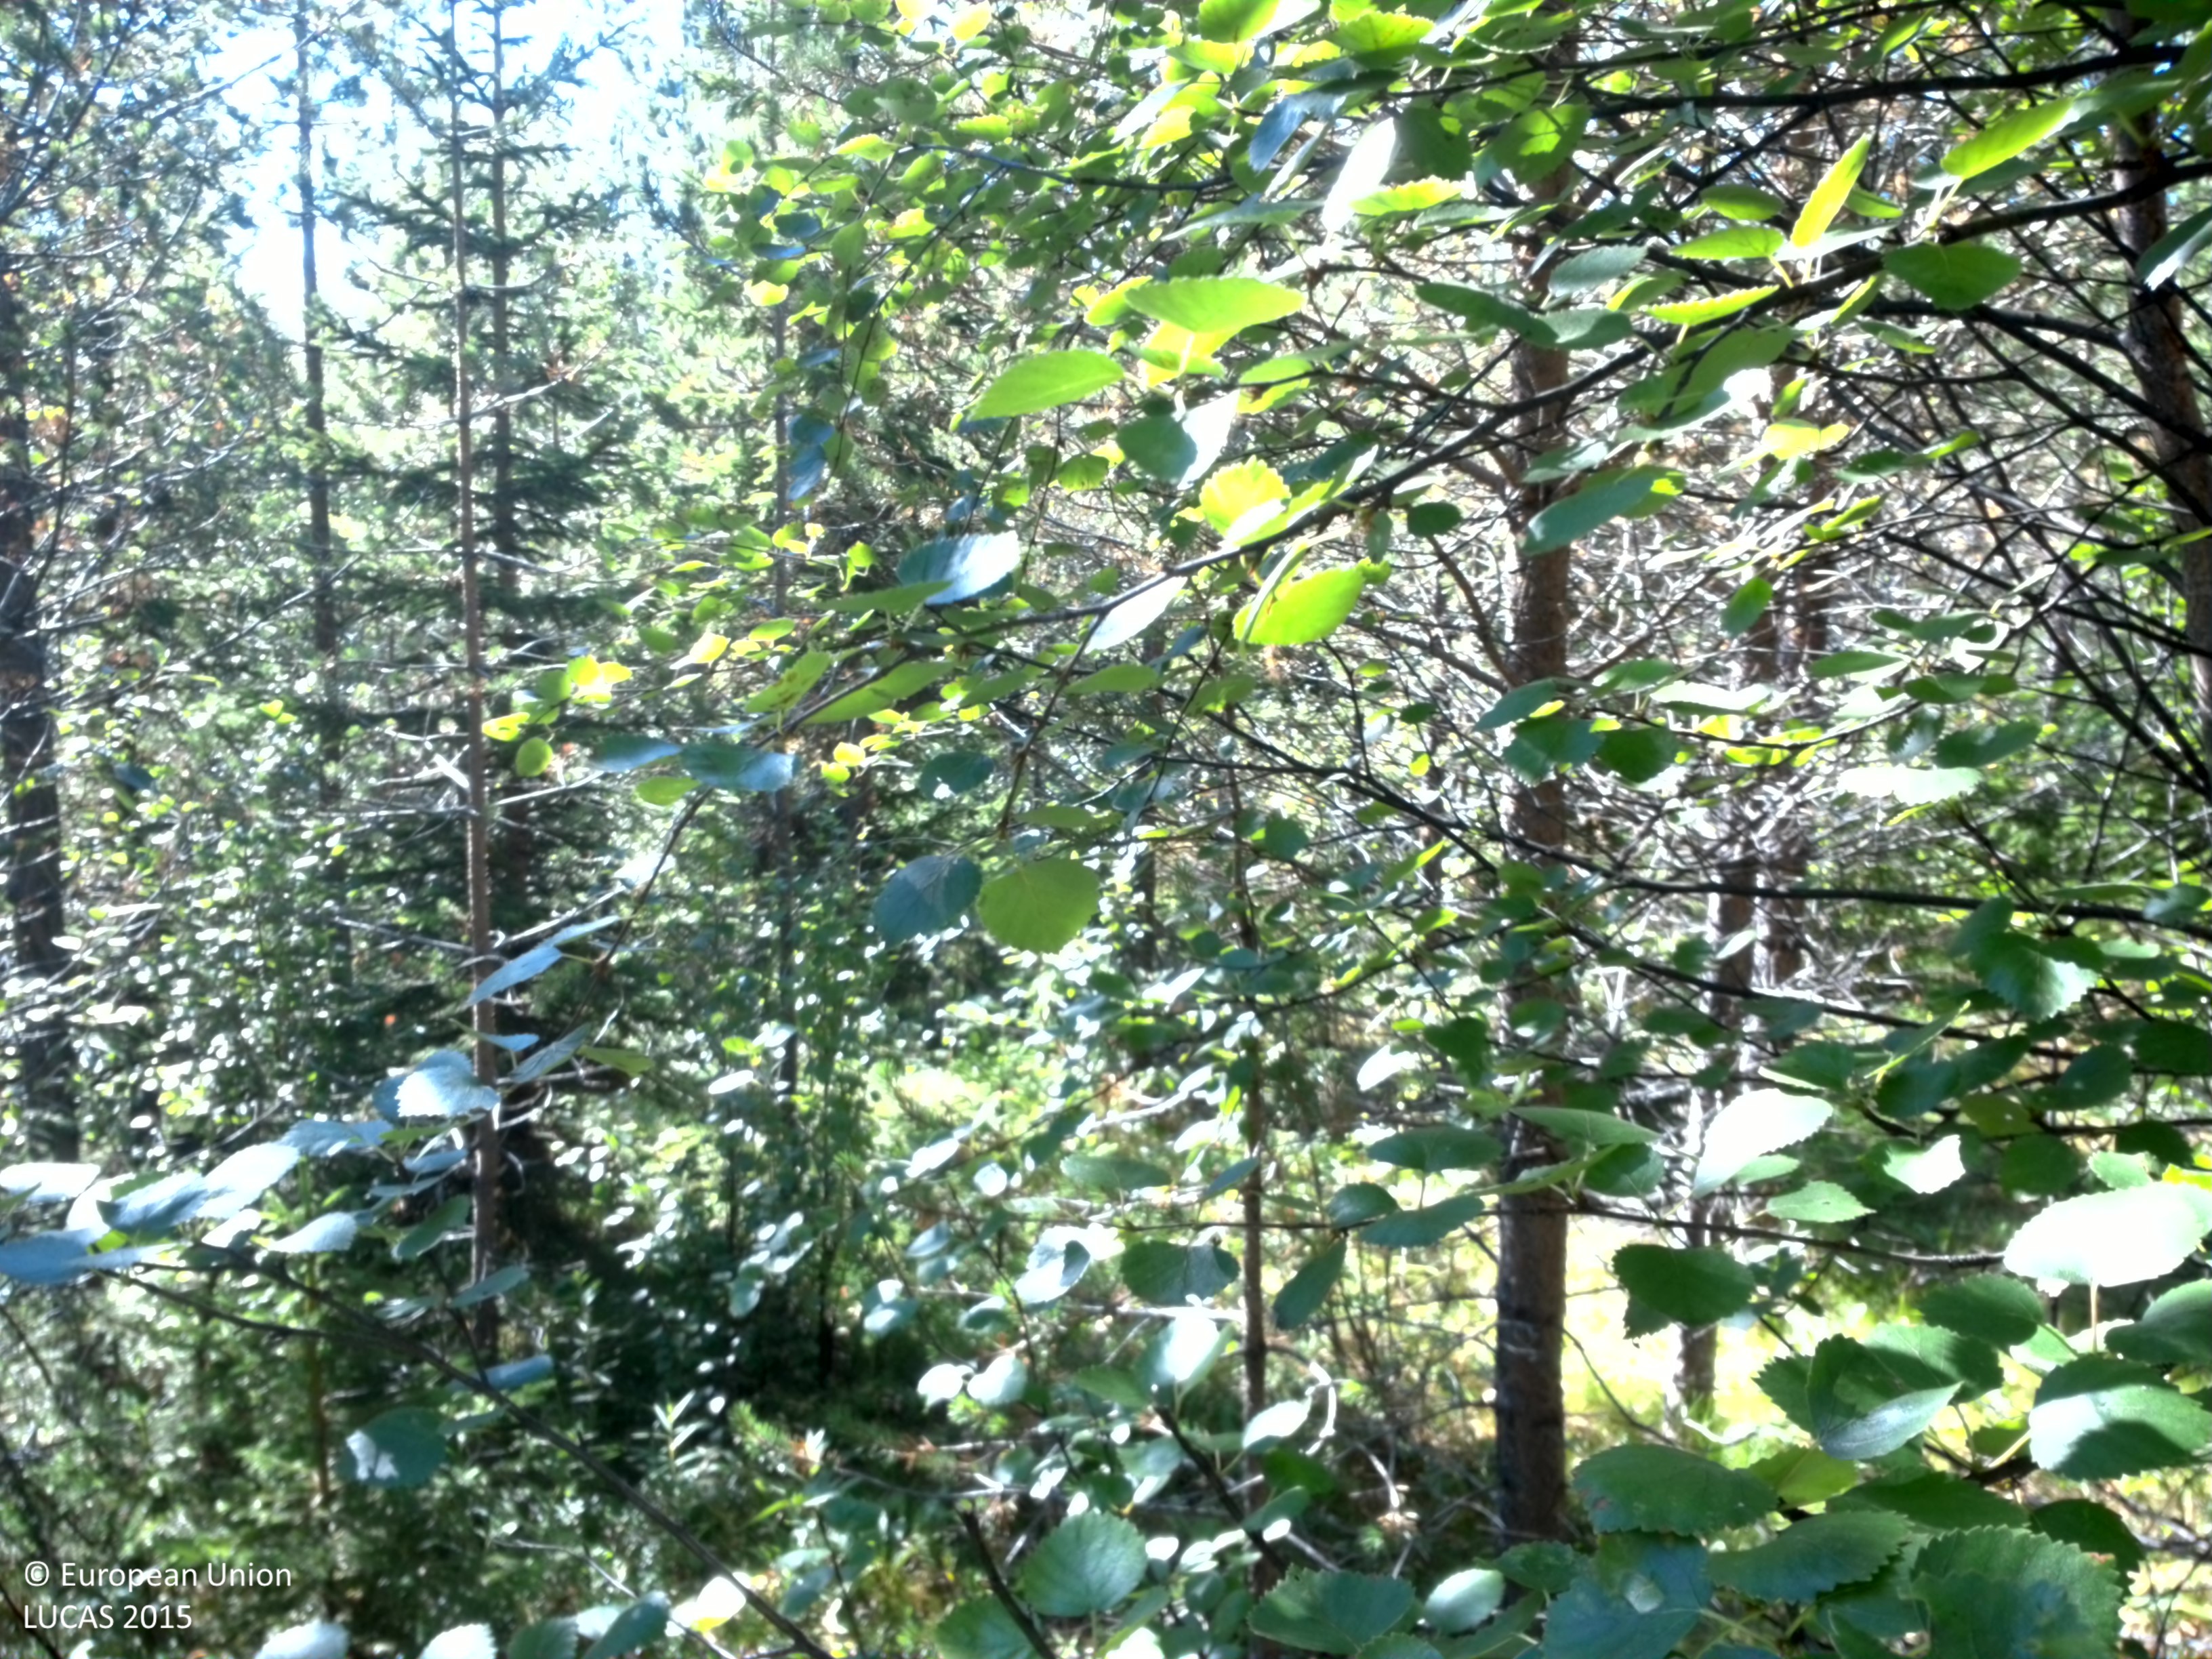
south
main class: Woodland
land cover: Pine dominated coniferous woodland
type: boreal forest
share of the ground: 50 - 75 %
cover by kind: coniferous forest trees 50 %, herbaceous plants 20 %, shrubs 15 %, lichens and mosses 10 %, broadleaved forest trees 5 %
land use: Forestry
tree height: > 5 m
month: August
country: SE
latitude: 64.7902
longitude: 16.0481
